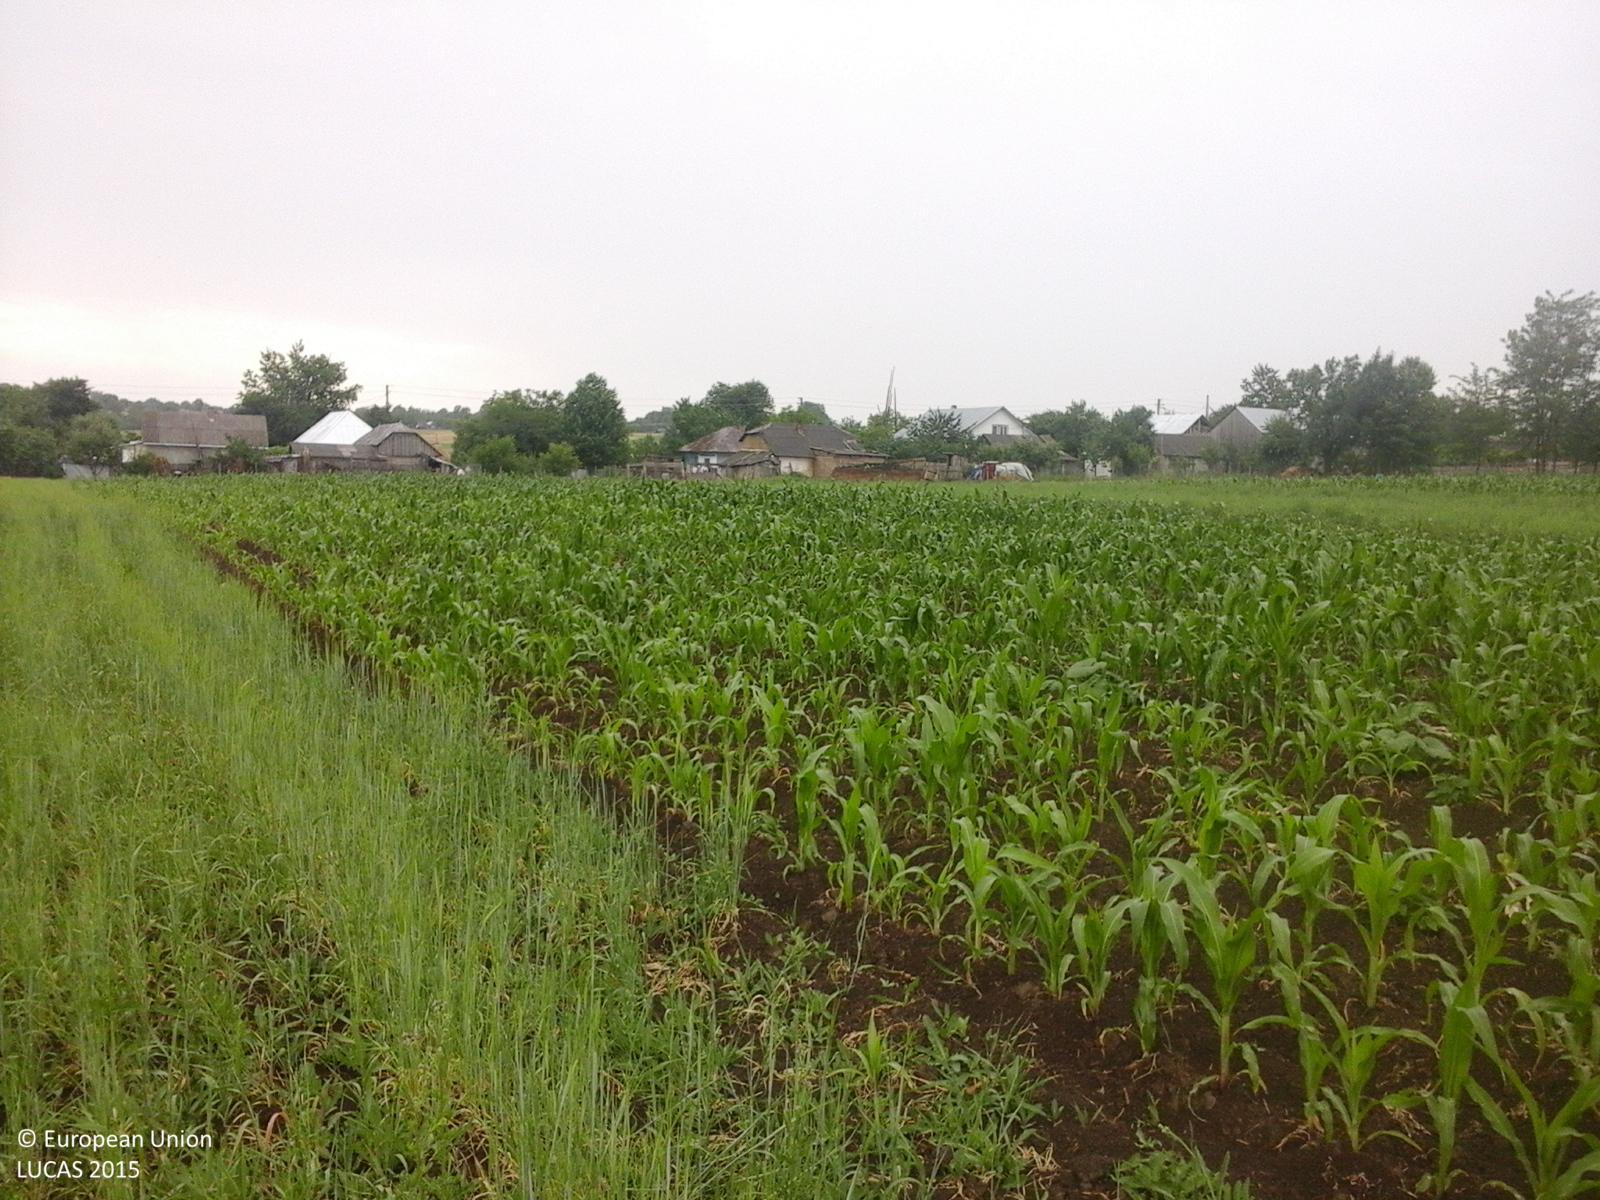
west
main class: Cropland
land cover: Barley
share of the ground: > 75 %
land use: Agriculture (excluding fallow land and kitchen gardens)
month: June
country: RO
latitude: 47.3383
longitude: 26.4853
